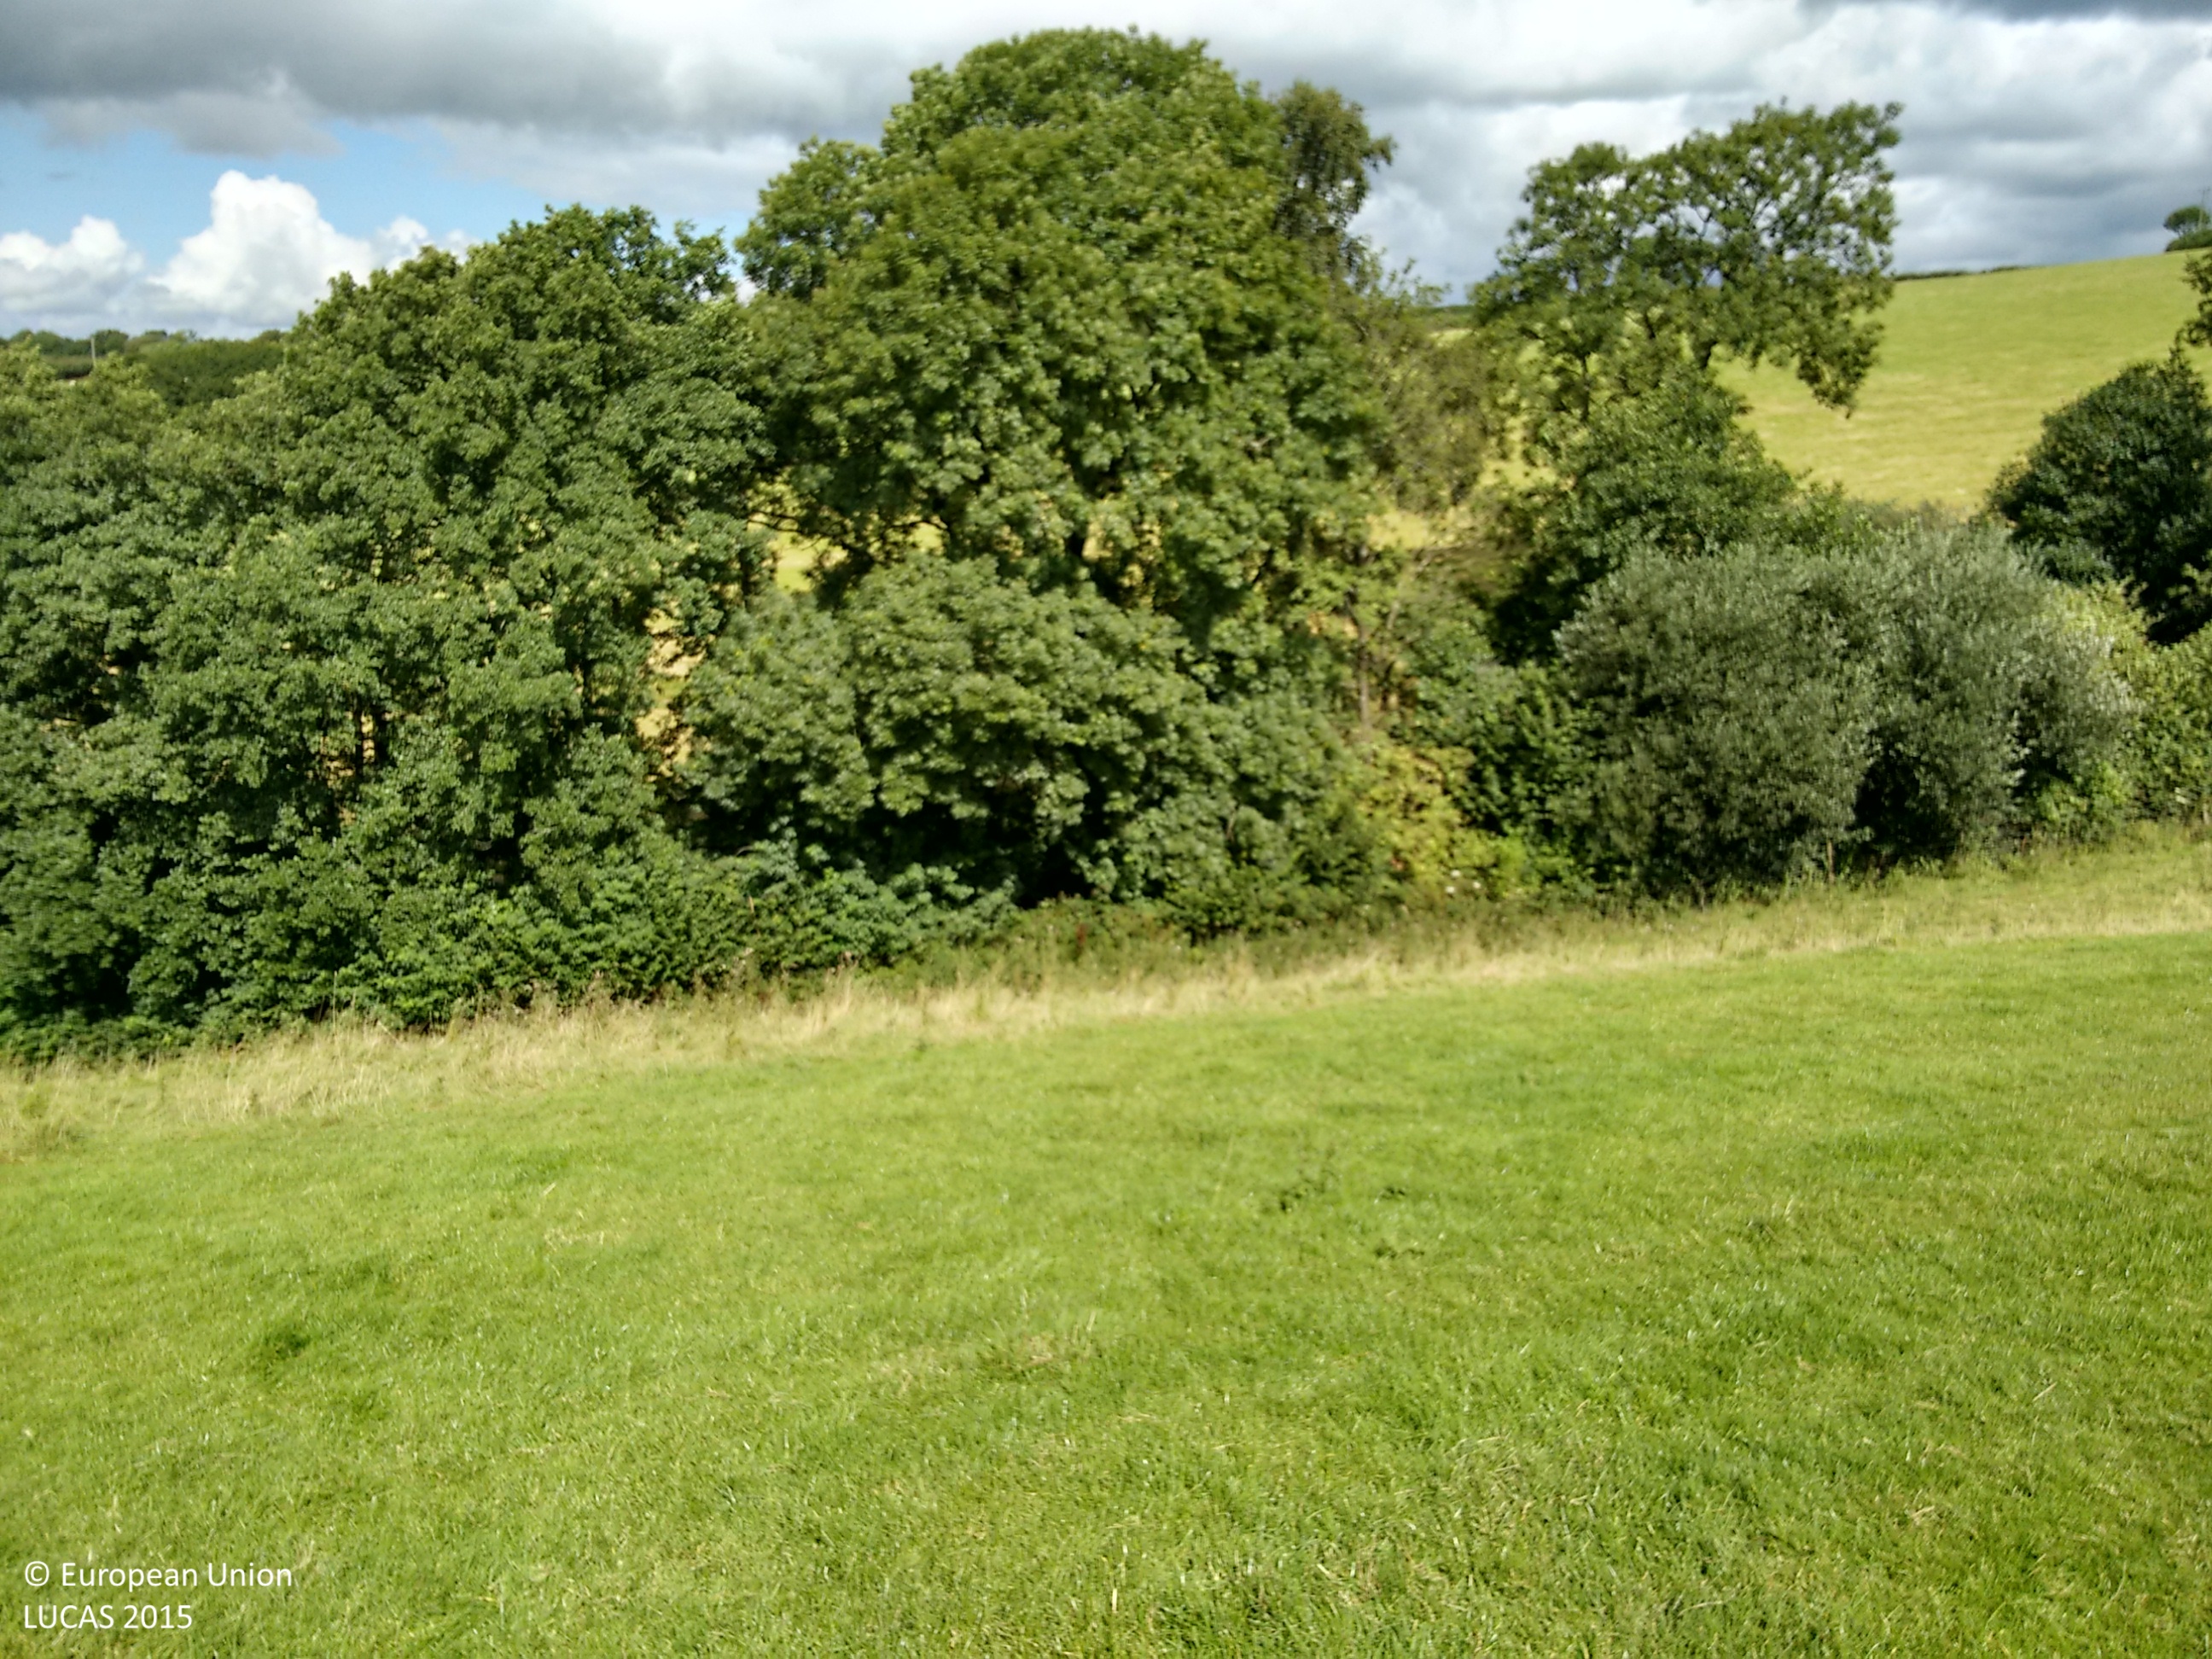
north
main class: Grassland
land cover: Grassland without tree/shrub cover
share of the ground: > 75 %
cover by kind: herbaceous plants 100 %
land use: Agriculture (excluding fallow land and kitchen gardens)
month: August
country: GB
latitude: 50.9814
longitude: -3.8072
